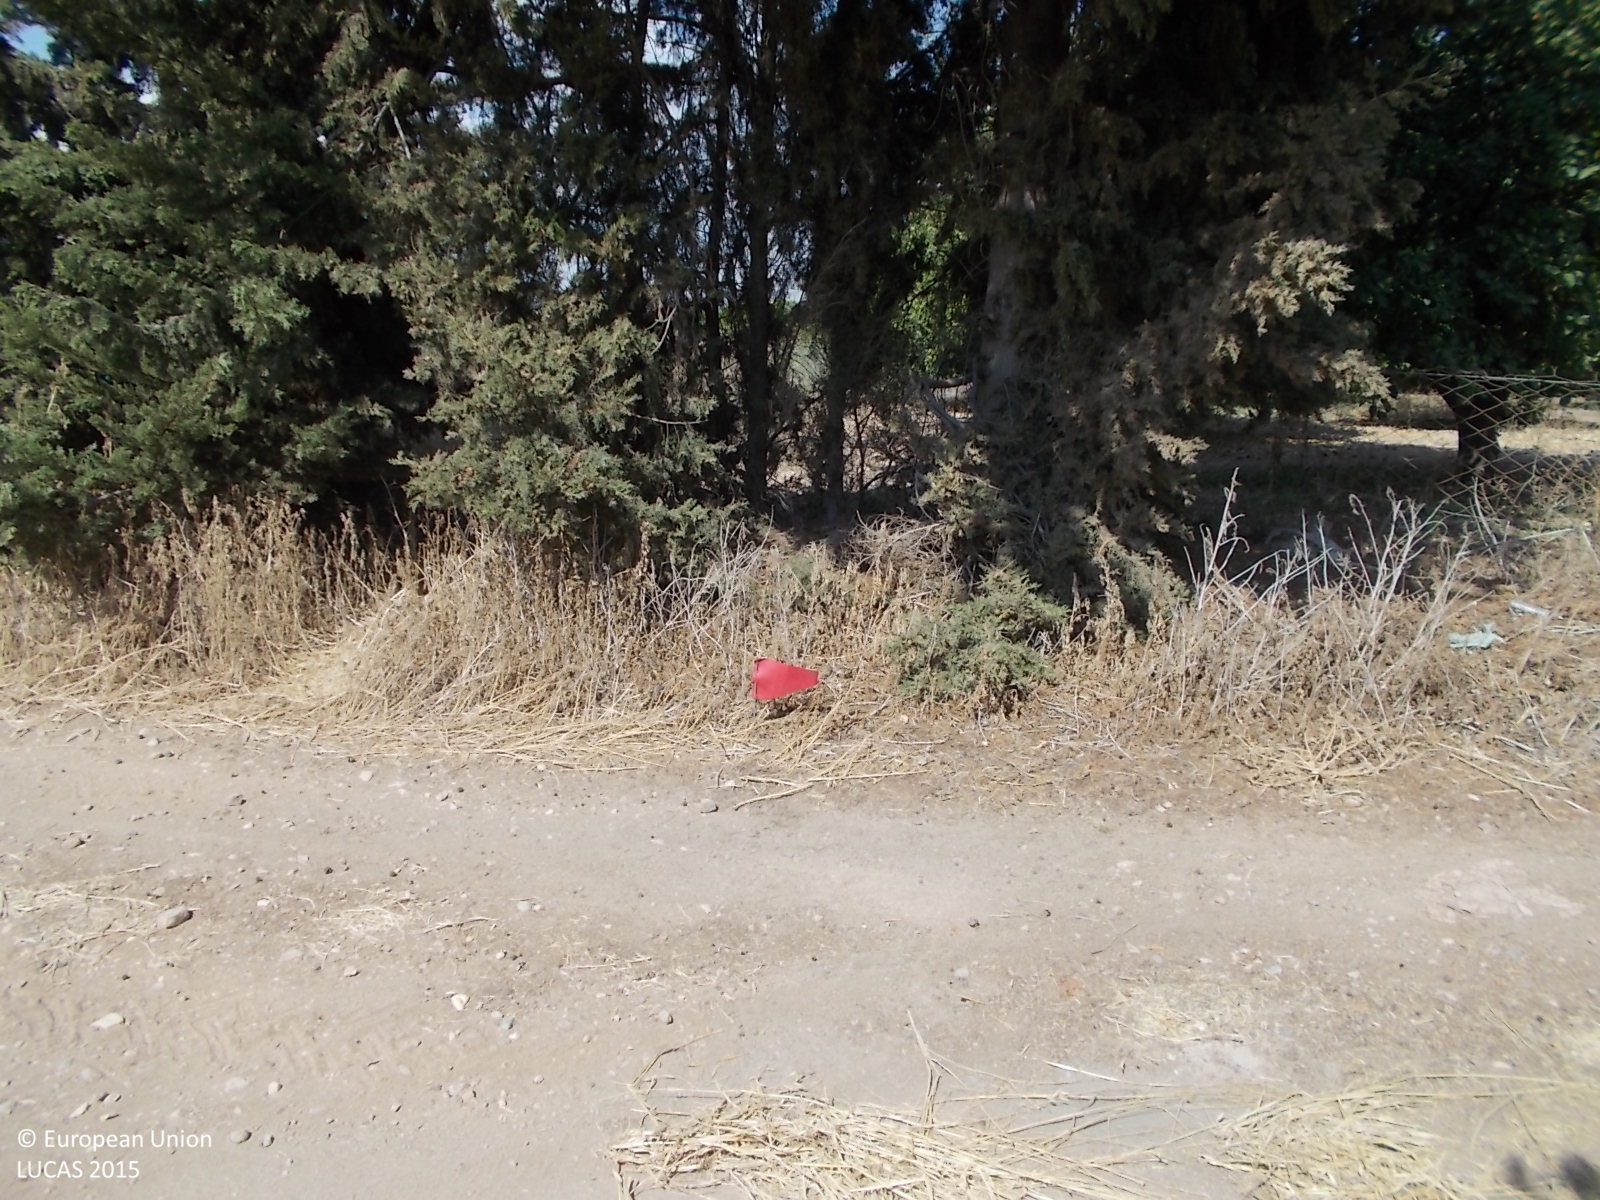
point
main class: Woodland
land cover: Other coniferous woodland
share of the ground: 50 - 75 %
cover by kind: coniferous forest trees 65 %, herbaceous plants 35 %
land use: Agriculture (excluding fallow land and kitchen gardens)
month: May
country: CY
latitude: 34.7272
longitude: 32.5232
